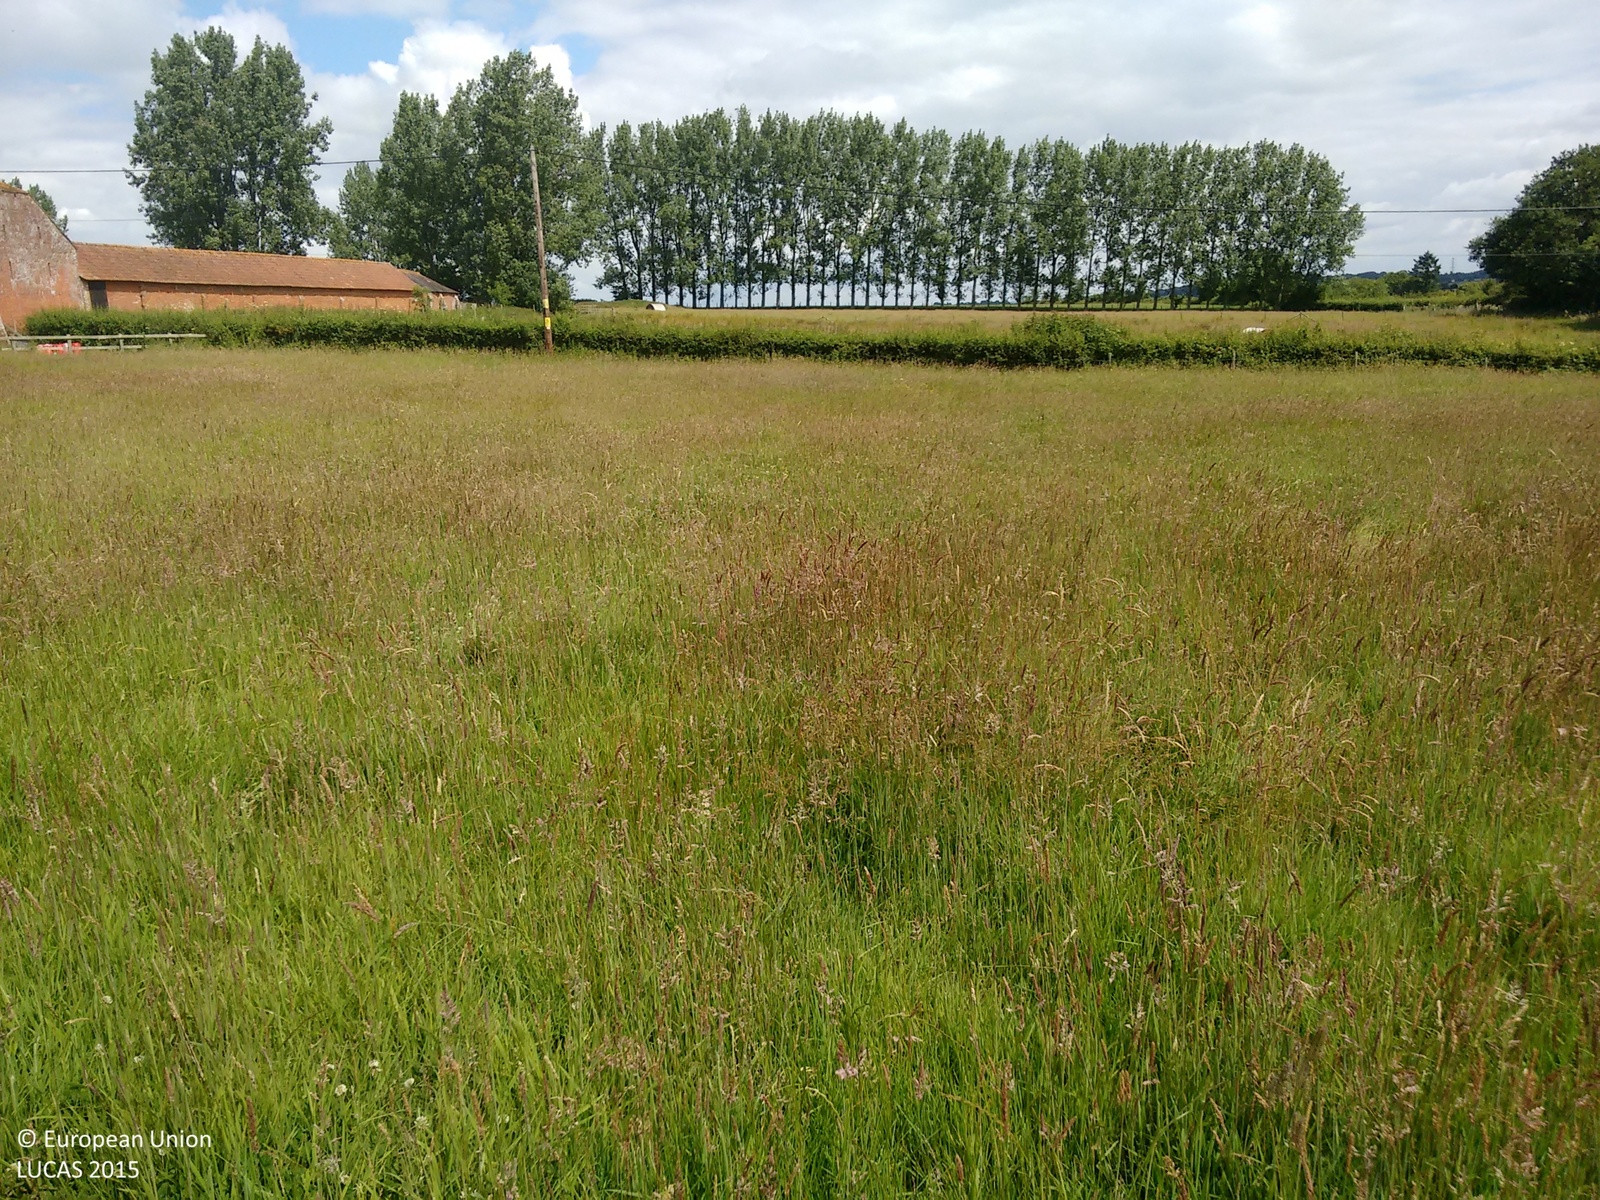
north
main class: Grassland
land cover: Grassland without tree/shrub cover
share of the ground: > 75 %
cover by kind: herbaceous plants 100 %
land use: Agriculture (excluding fallow land and kitchen gardens)
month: June
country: GB
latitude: 50.7797
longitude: -2.0430
